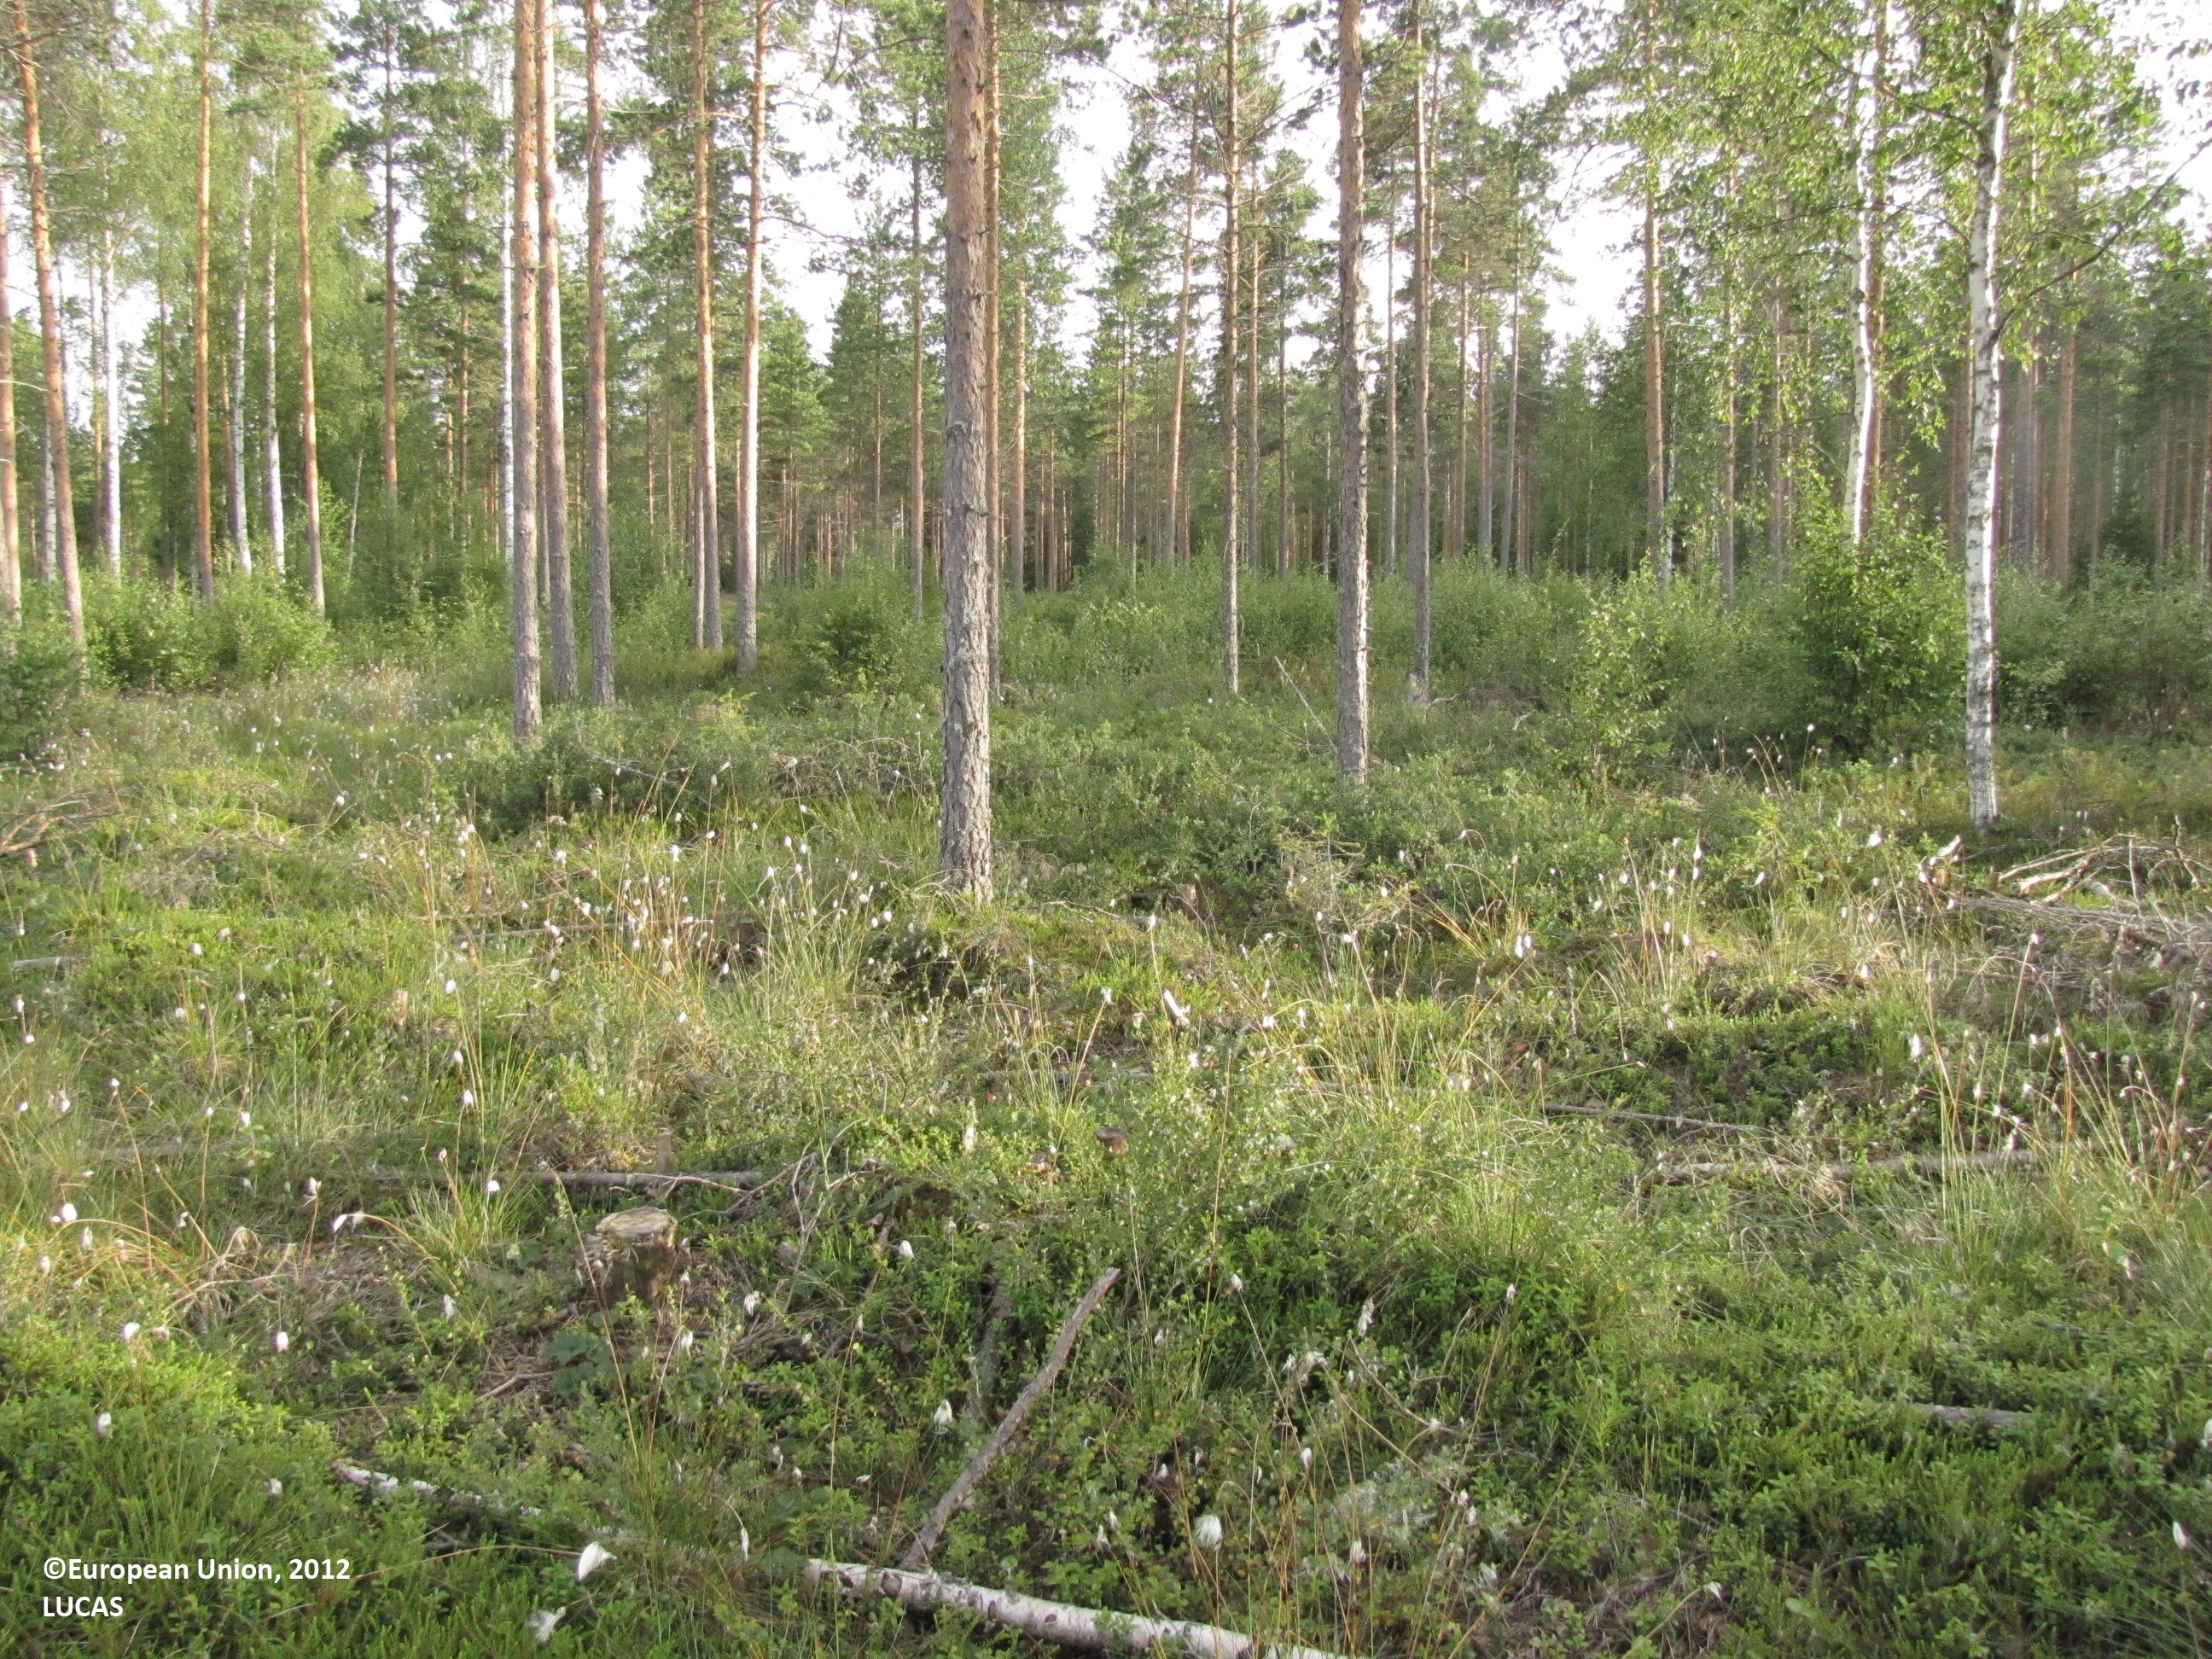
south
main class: Woodland
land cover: Pine dominated coniferous woodland
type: mire and swamp forests
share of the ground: 50 - 75 %
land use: Forestry
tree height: > 5 m
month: July
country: FI
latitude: 62.4906
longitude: 23.5597
